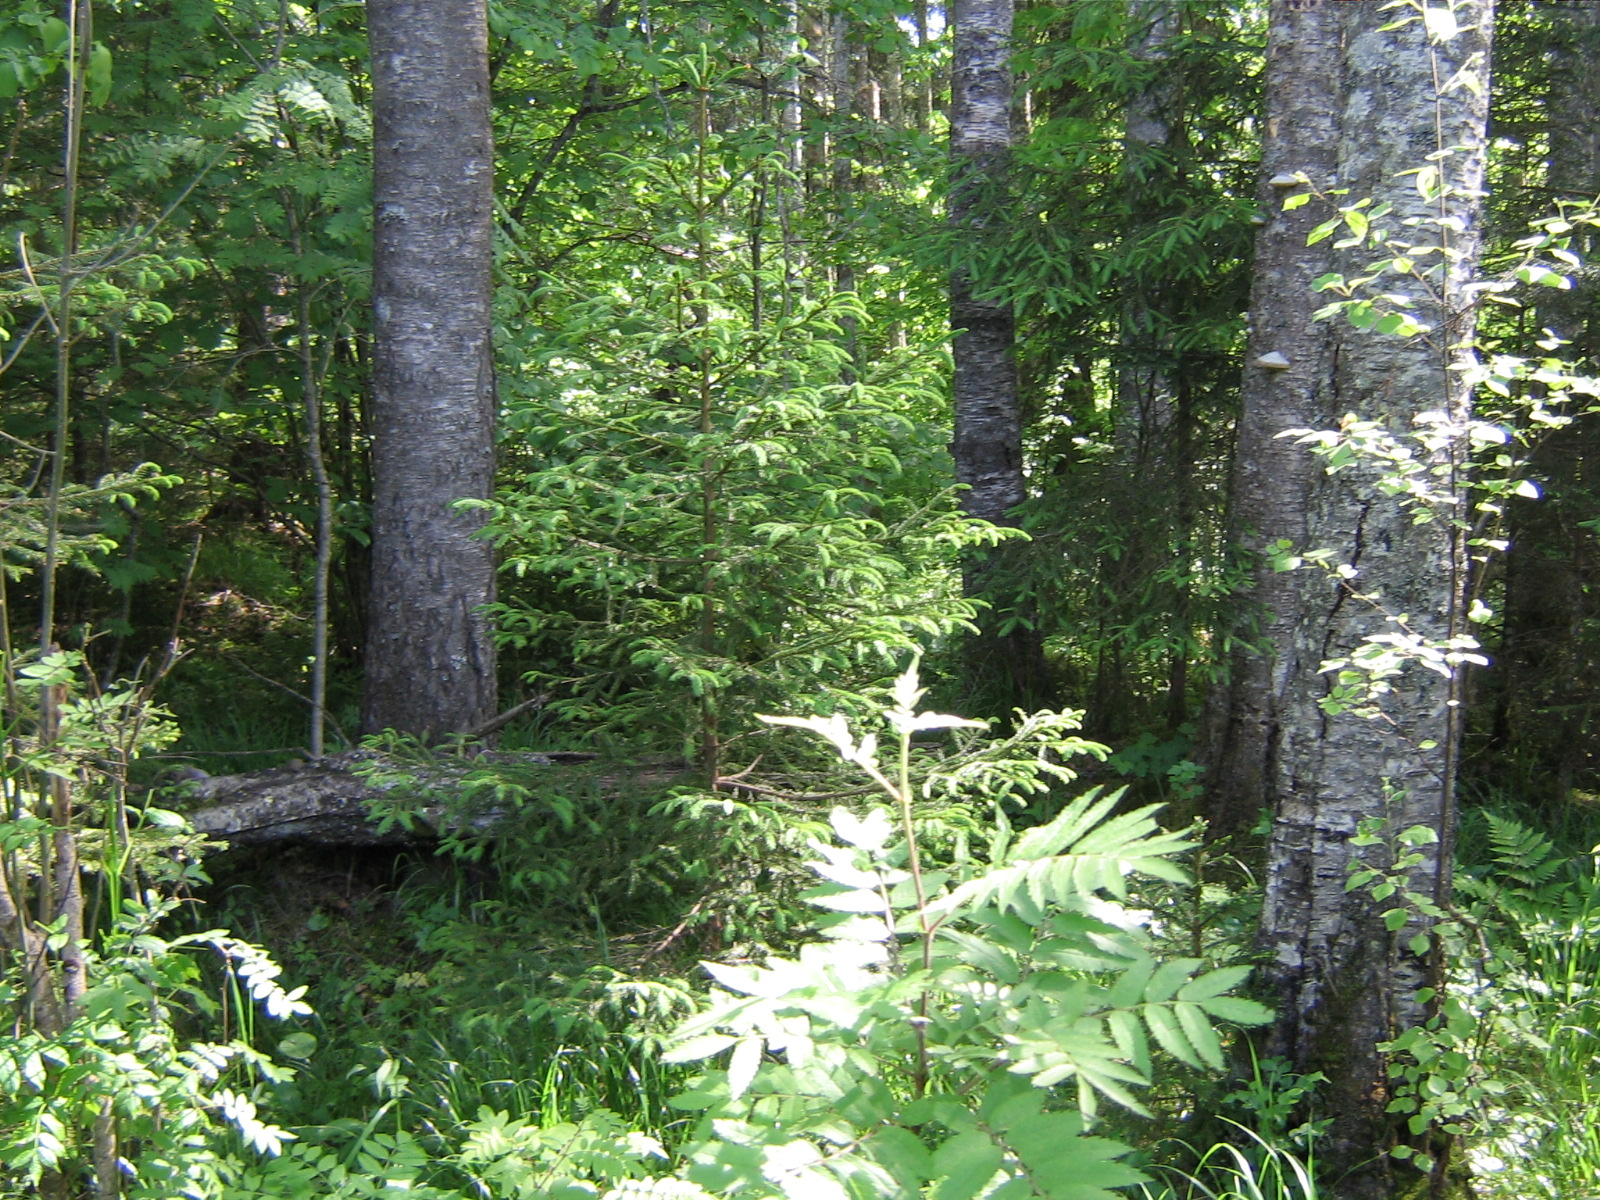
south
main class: Woodland
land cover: Spruce dominated mixed woodland
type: hemiboreal forest and nemoral coniferous forest and mixed broadleaved-coniferous forest
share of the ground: > 75 %
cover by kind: coniferous forest trees 65 %, broadleaved forest trees 35 %
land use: Forestry
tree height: > 5 m
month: June
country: LV
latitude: 56.8663
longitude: 25.3875
